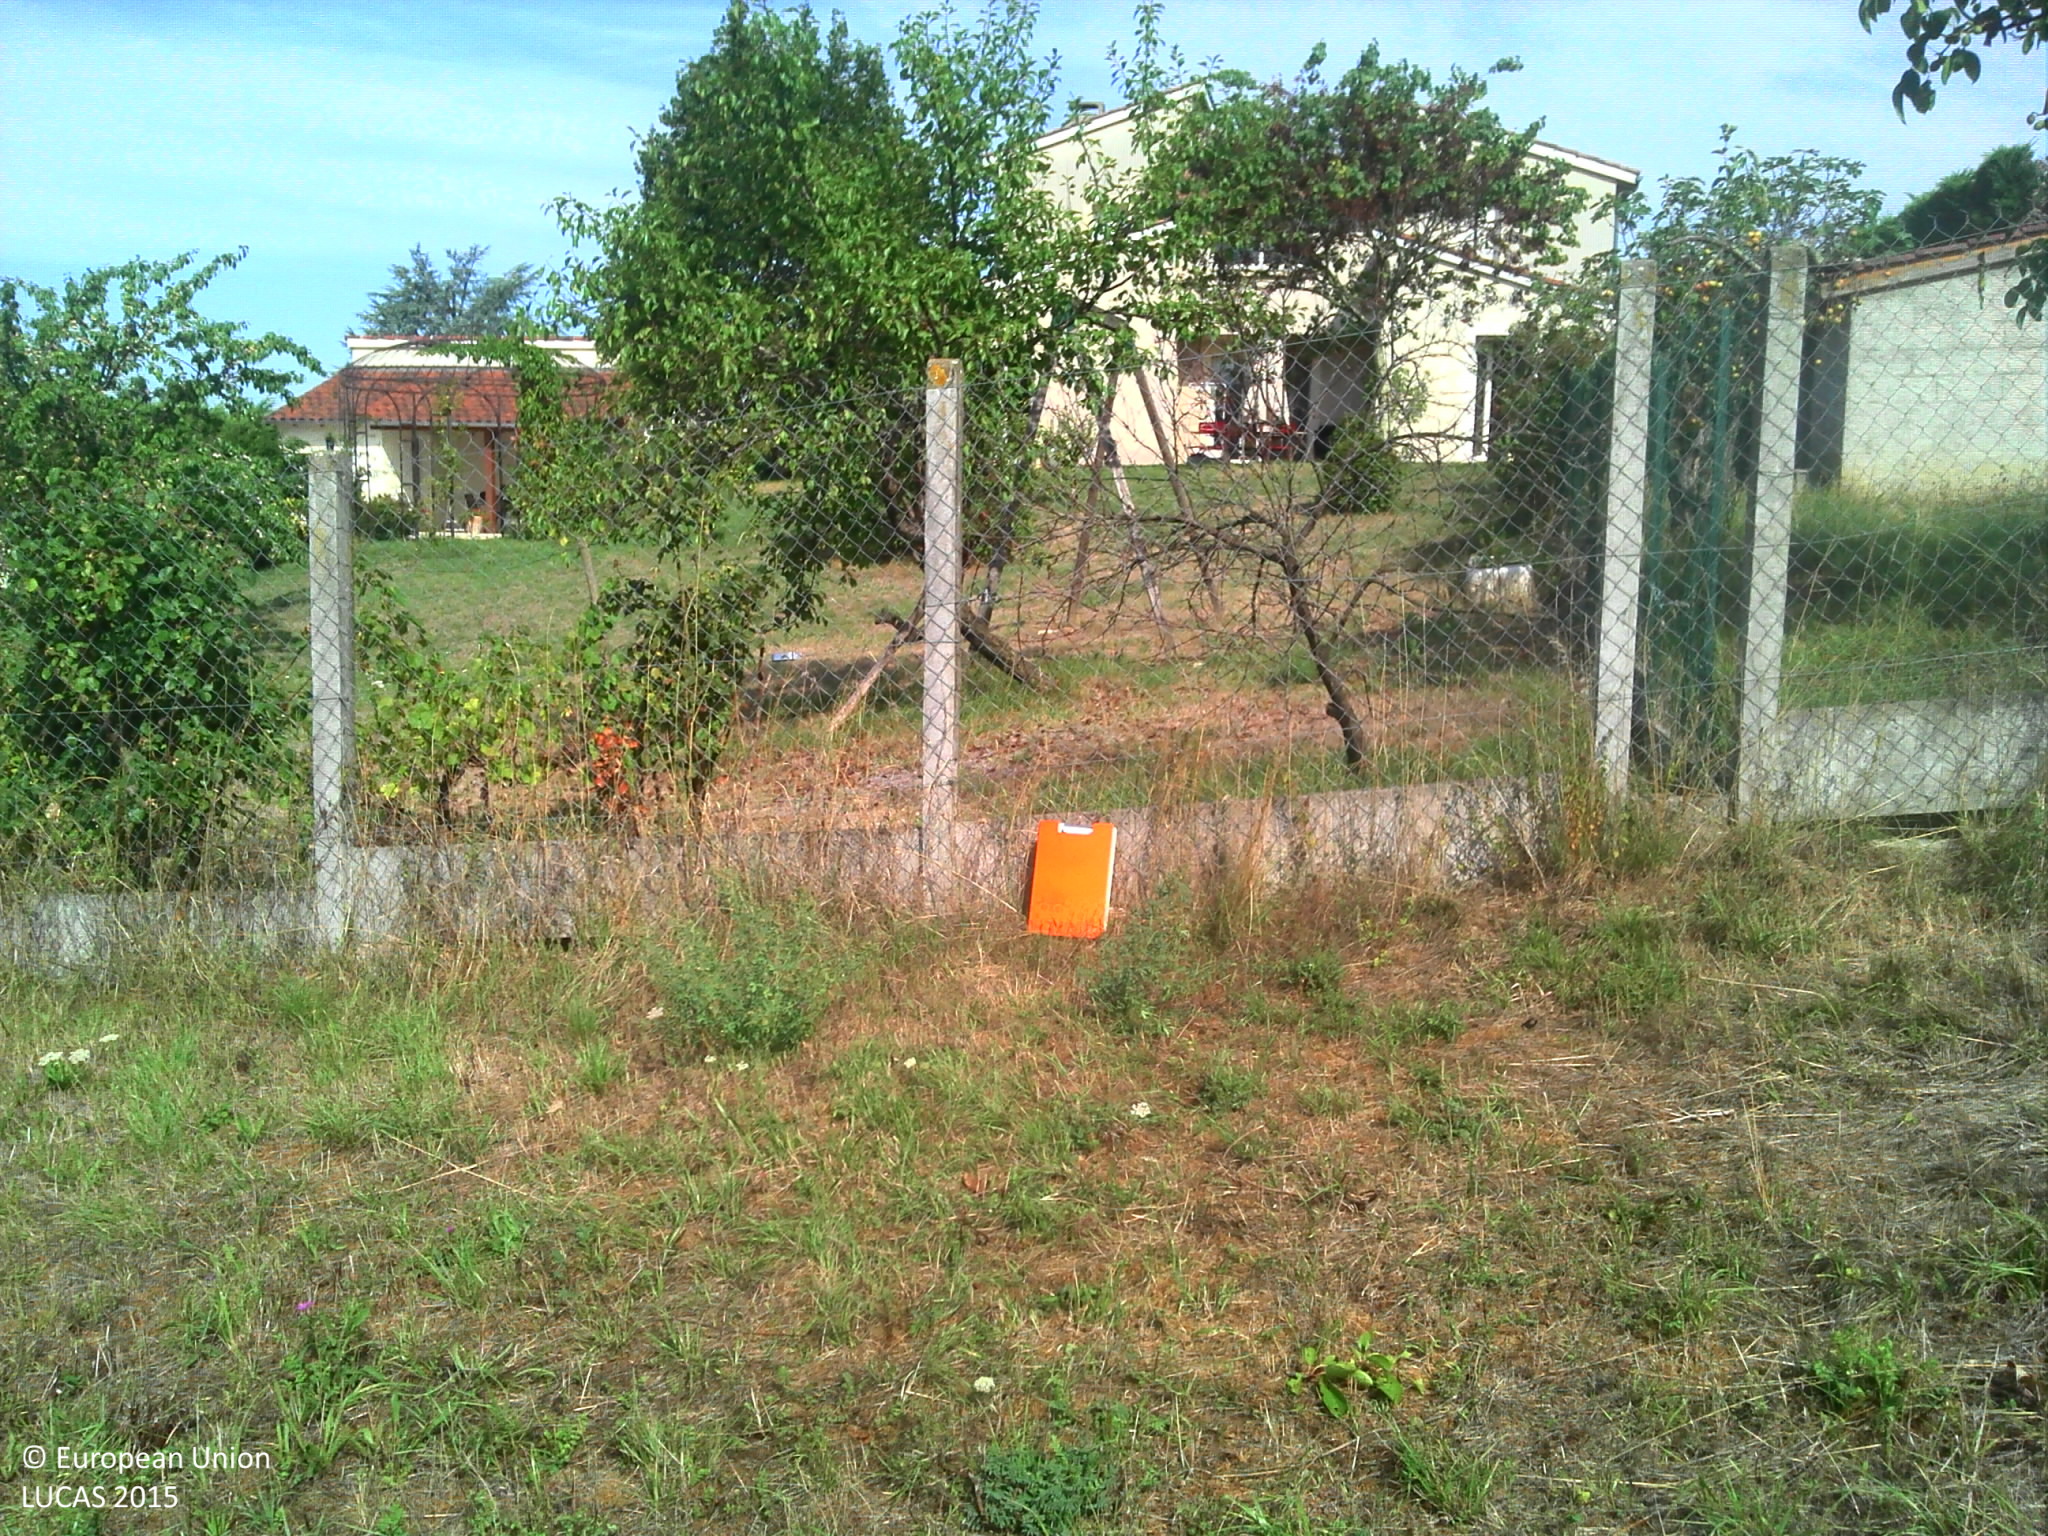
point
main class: Grassland
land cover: Grassland with sparse tree/shrub cover
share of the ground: > 75 %
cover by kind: herbaceous plants 85 %, shrubs 10 %, broadleaved forest trees 5 %
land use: Residential
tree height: > 5 m
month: August
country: FR
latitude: 44.8657
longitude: 1.8857
